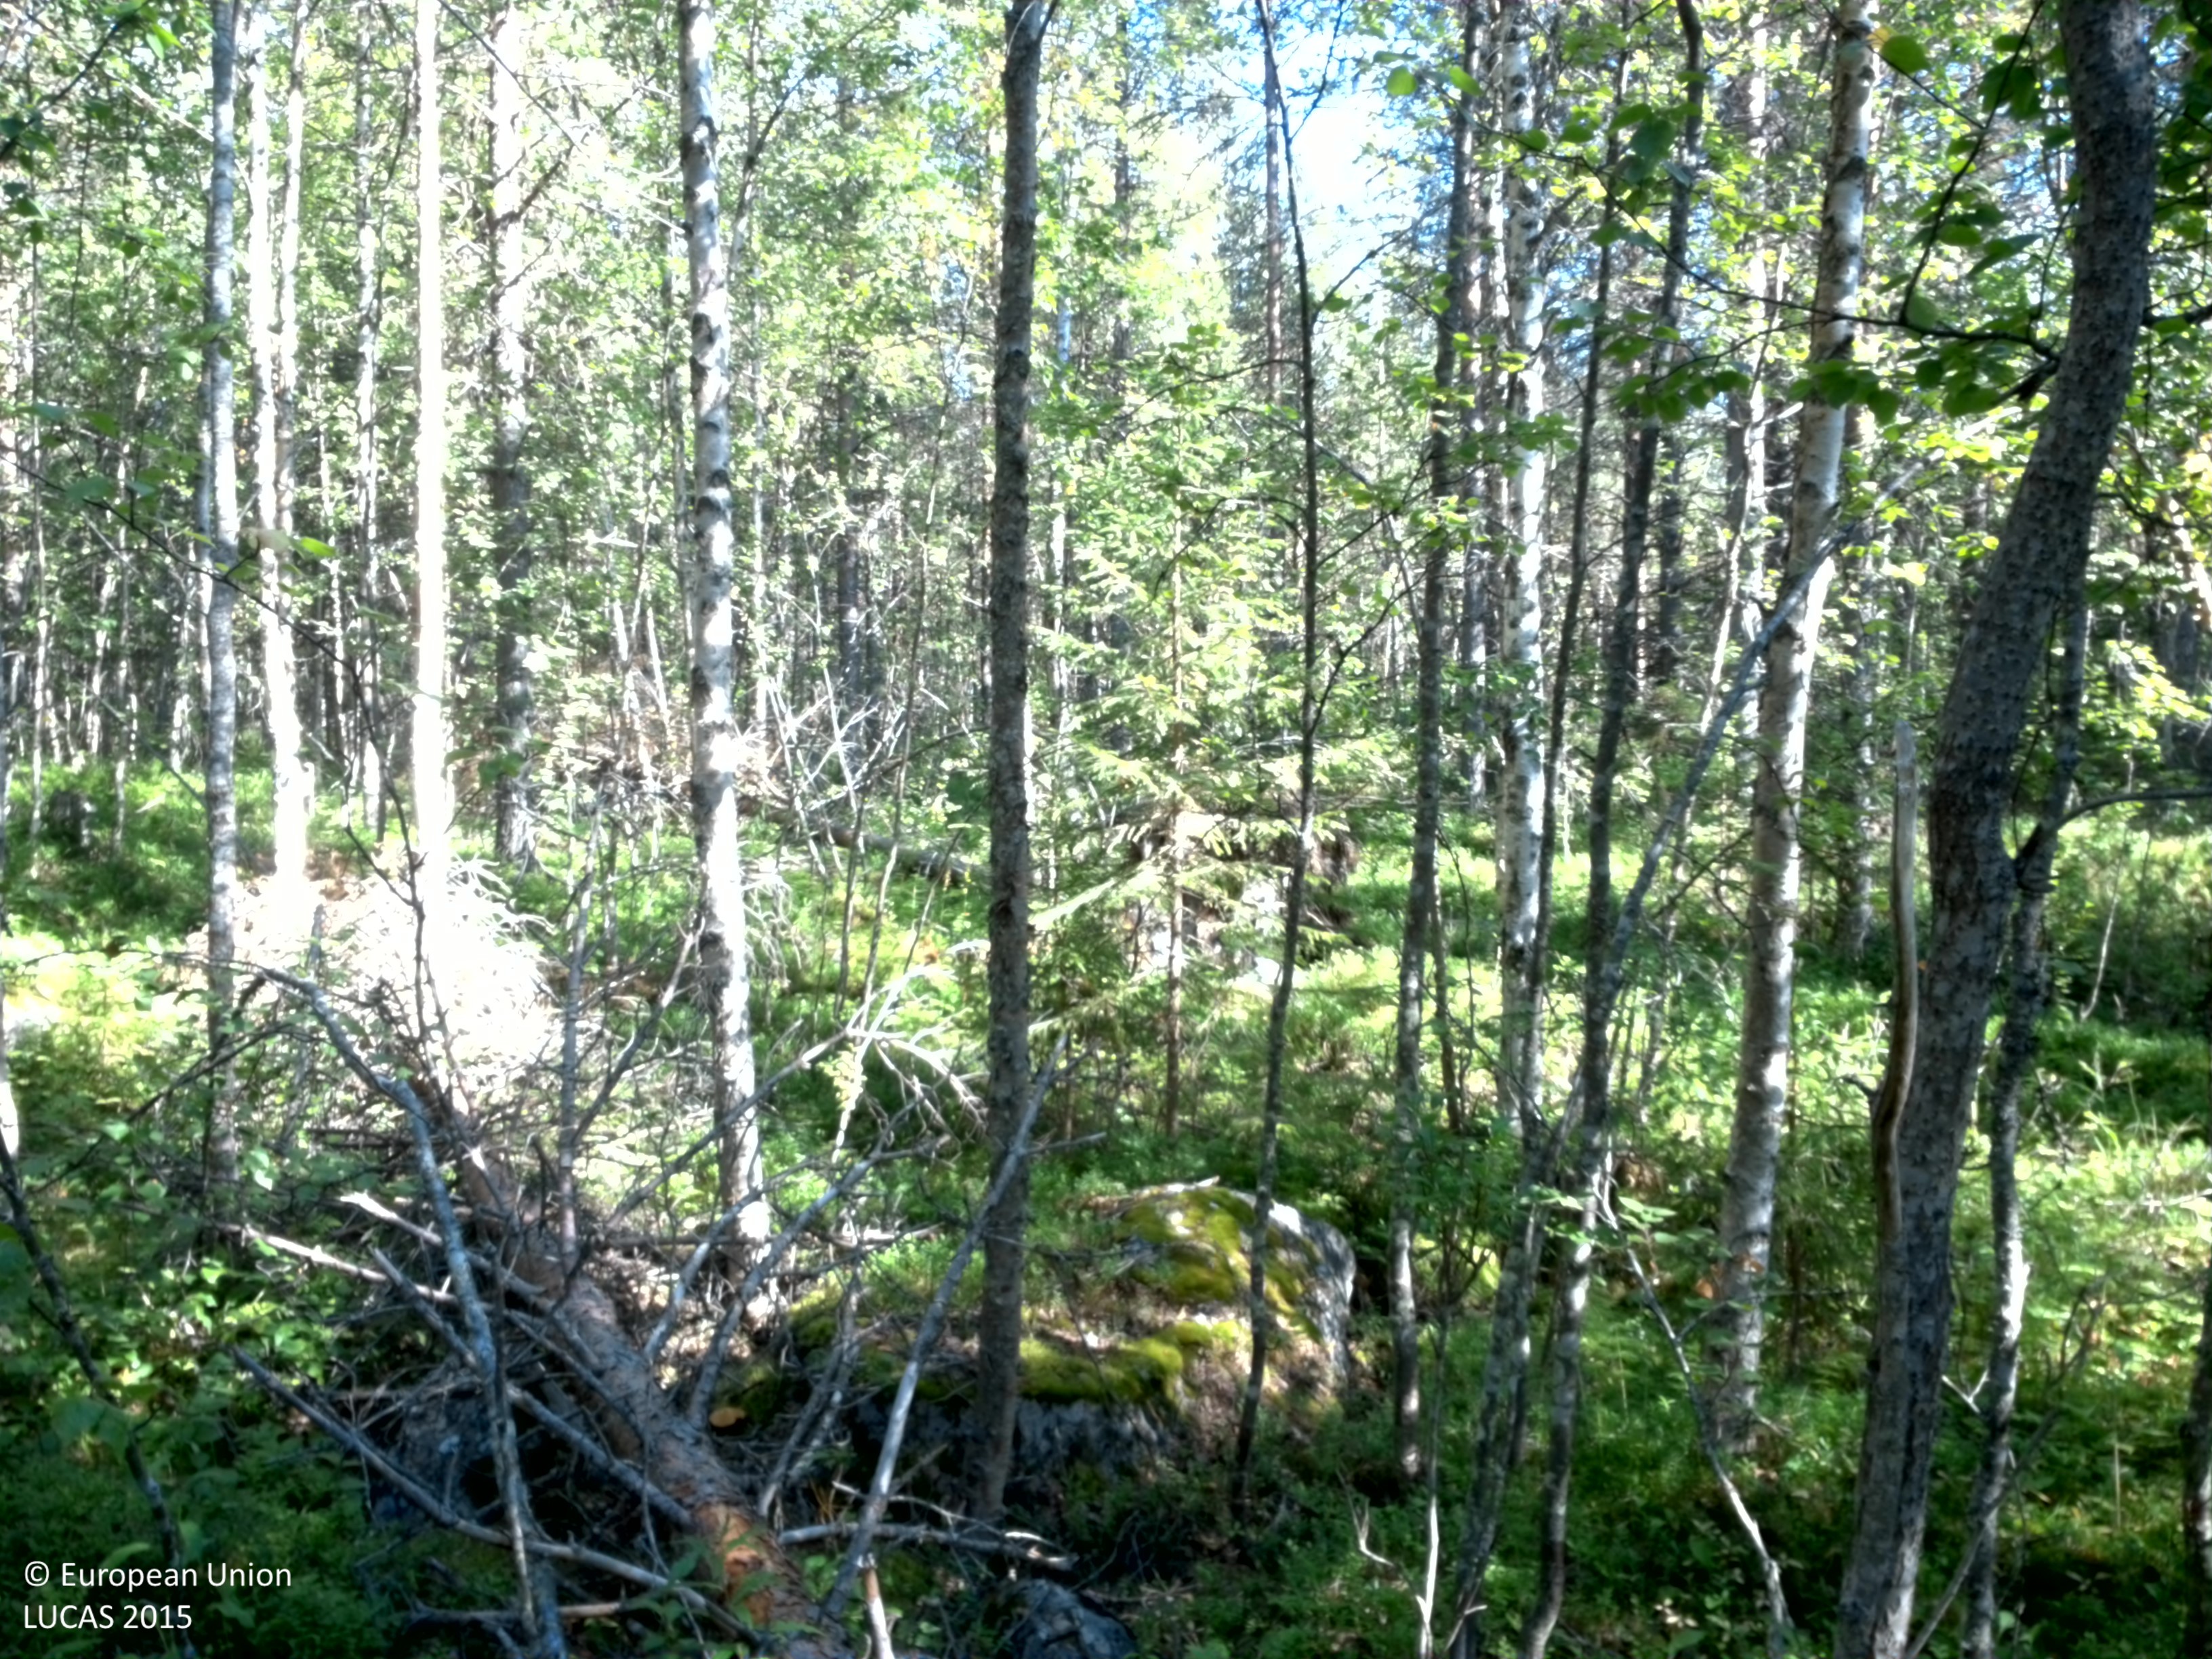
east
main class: Woodland
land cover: Pine dominated mixed woodland
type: boreal forest
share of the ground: 50 - 75 %
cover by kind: coniferous forest trees 35 %, broadleaved forest trees 30 %, shrubs 25 %, herbaceous plants 10 %
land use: Forestry
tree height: > 5 m
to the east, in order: Pine dominated mixed woodland; Pine dominated coniferous woodland; Pine dominated mixed woodland; Shrubland with sparse tree cover; Spruce dominated mixed woodland
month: August
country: SE
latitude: 64.6740
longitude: 16.6920
